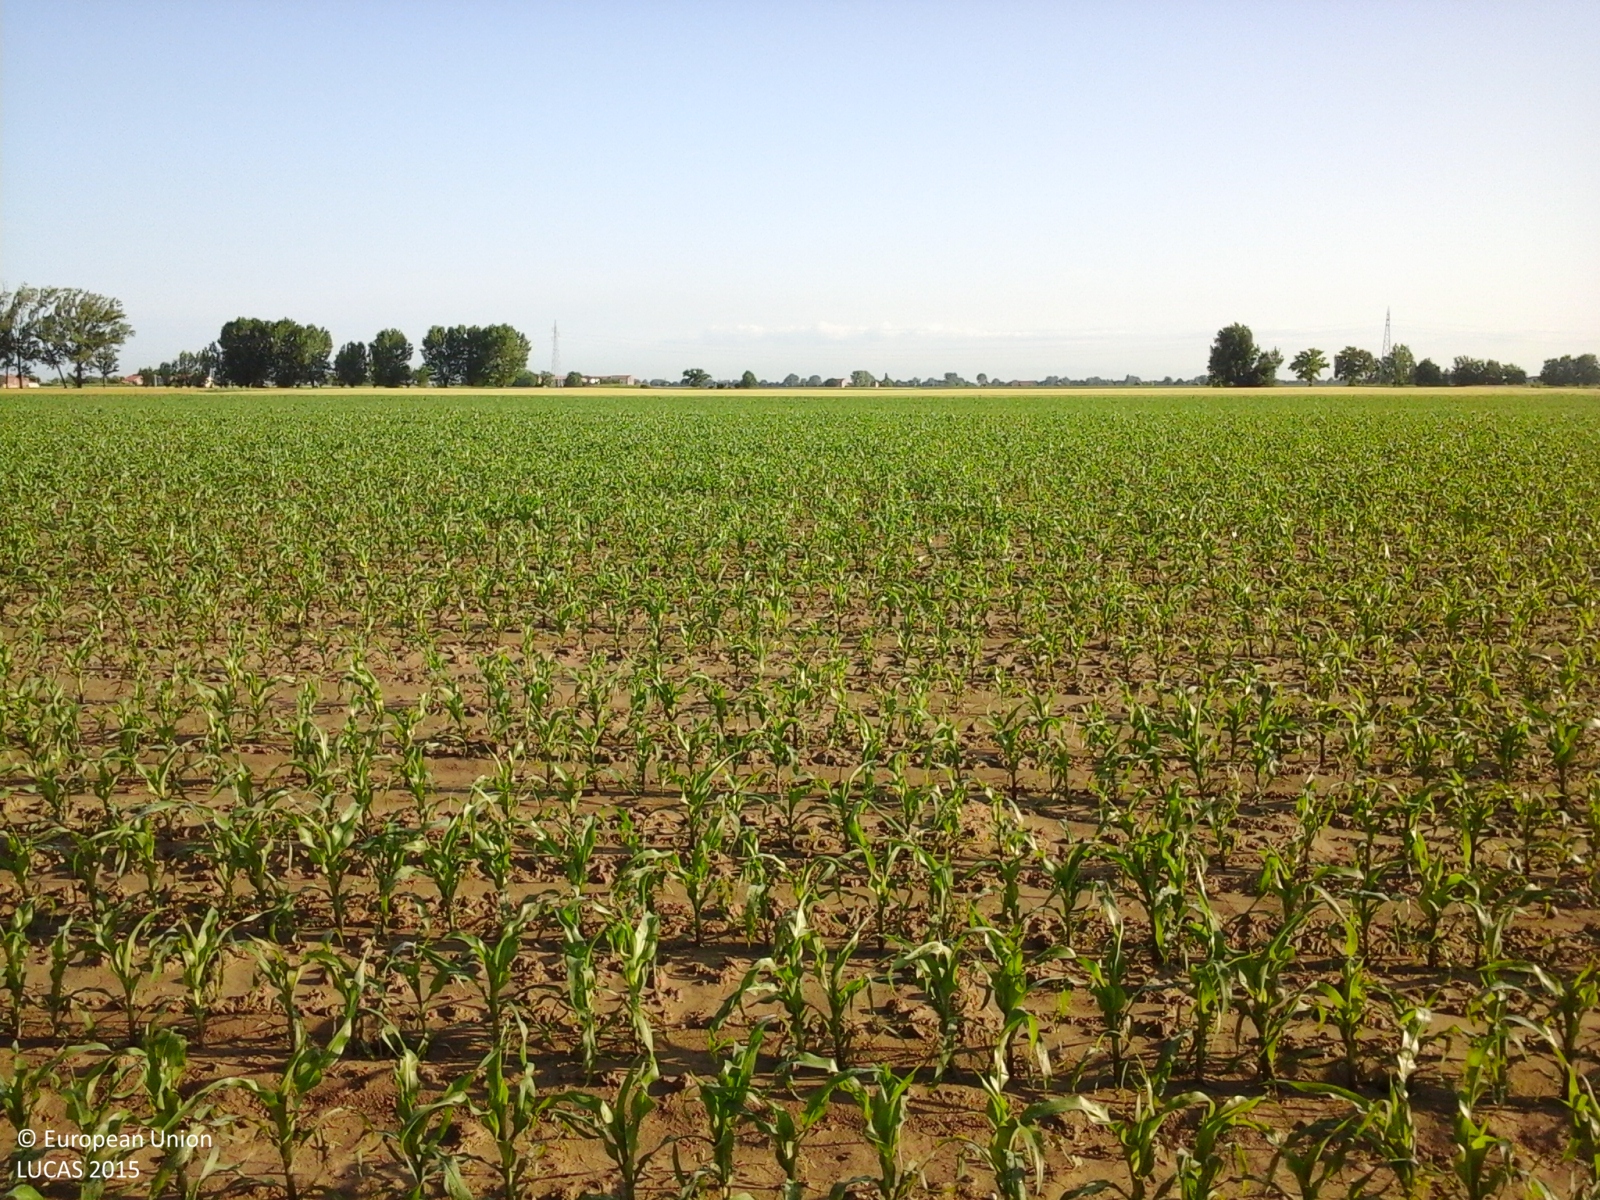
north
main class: Cropland
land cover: Maize
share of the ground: 25 - 50 %
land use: Agriculture (excluding fallow land and kitchen gardens)
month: May
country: IT
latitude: 45.0646
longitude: 11.2296
